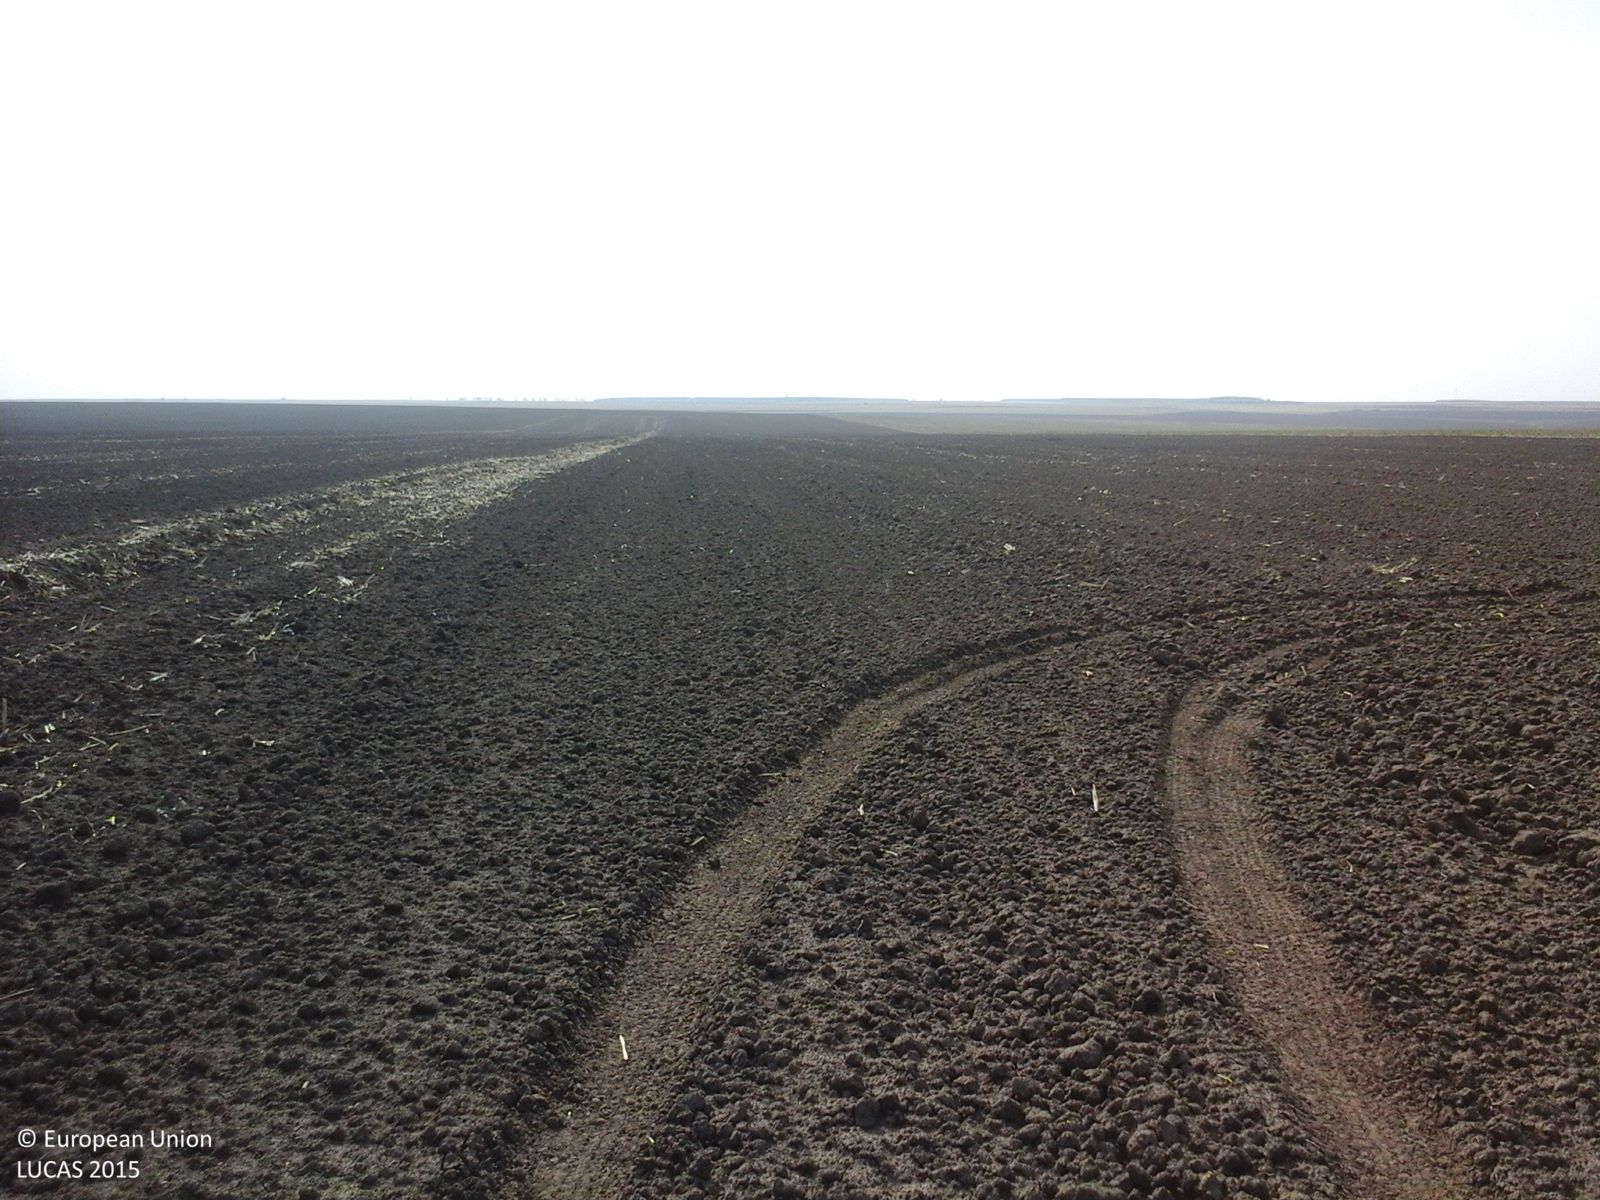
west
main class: Cropland
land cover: Common wheat
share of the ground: < 10 %
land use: Agriculture (excluding fallow land and kitchen gardens)
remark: Harvested field
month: August
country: RO
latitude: 44.0450
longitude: 28.3470
